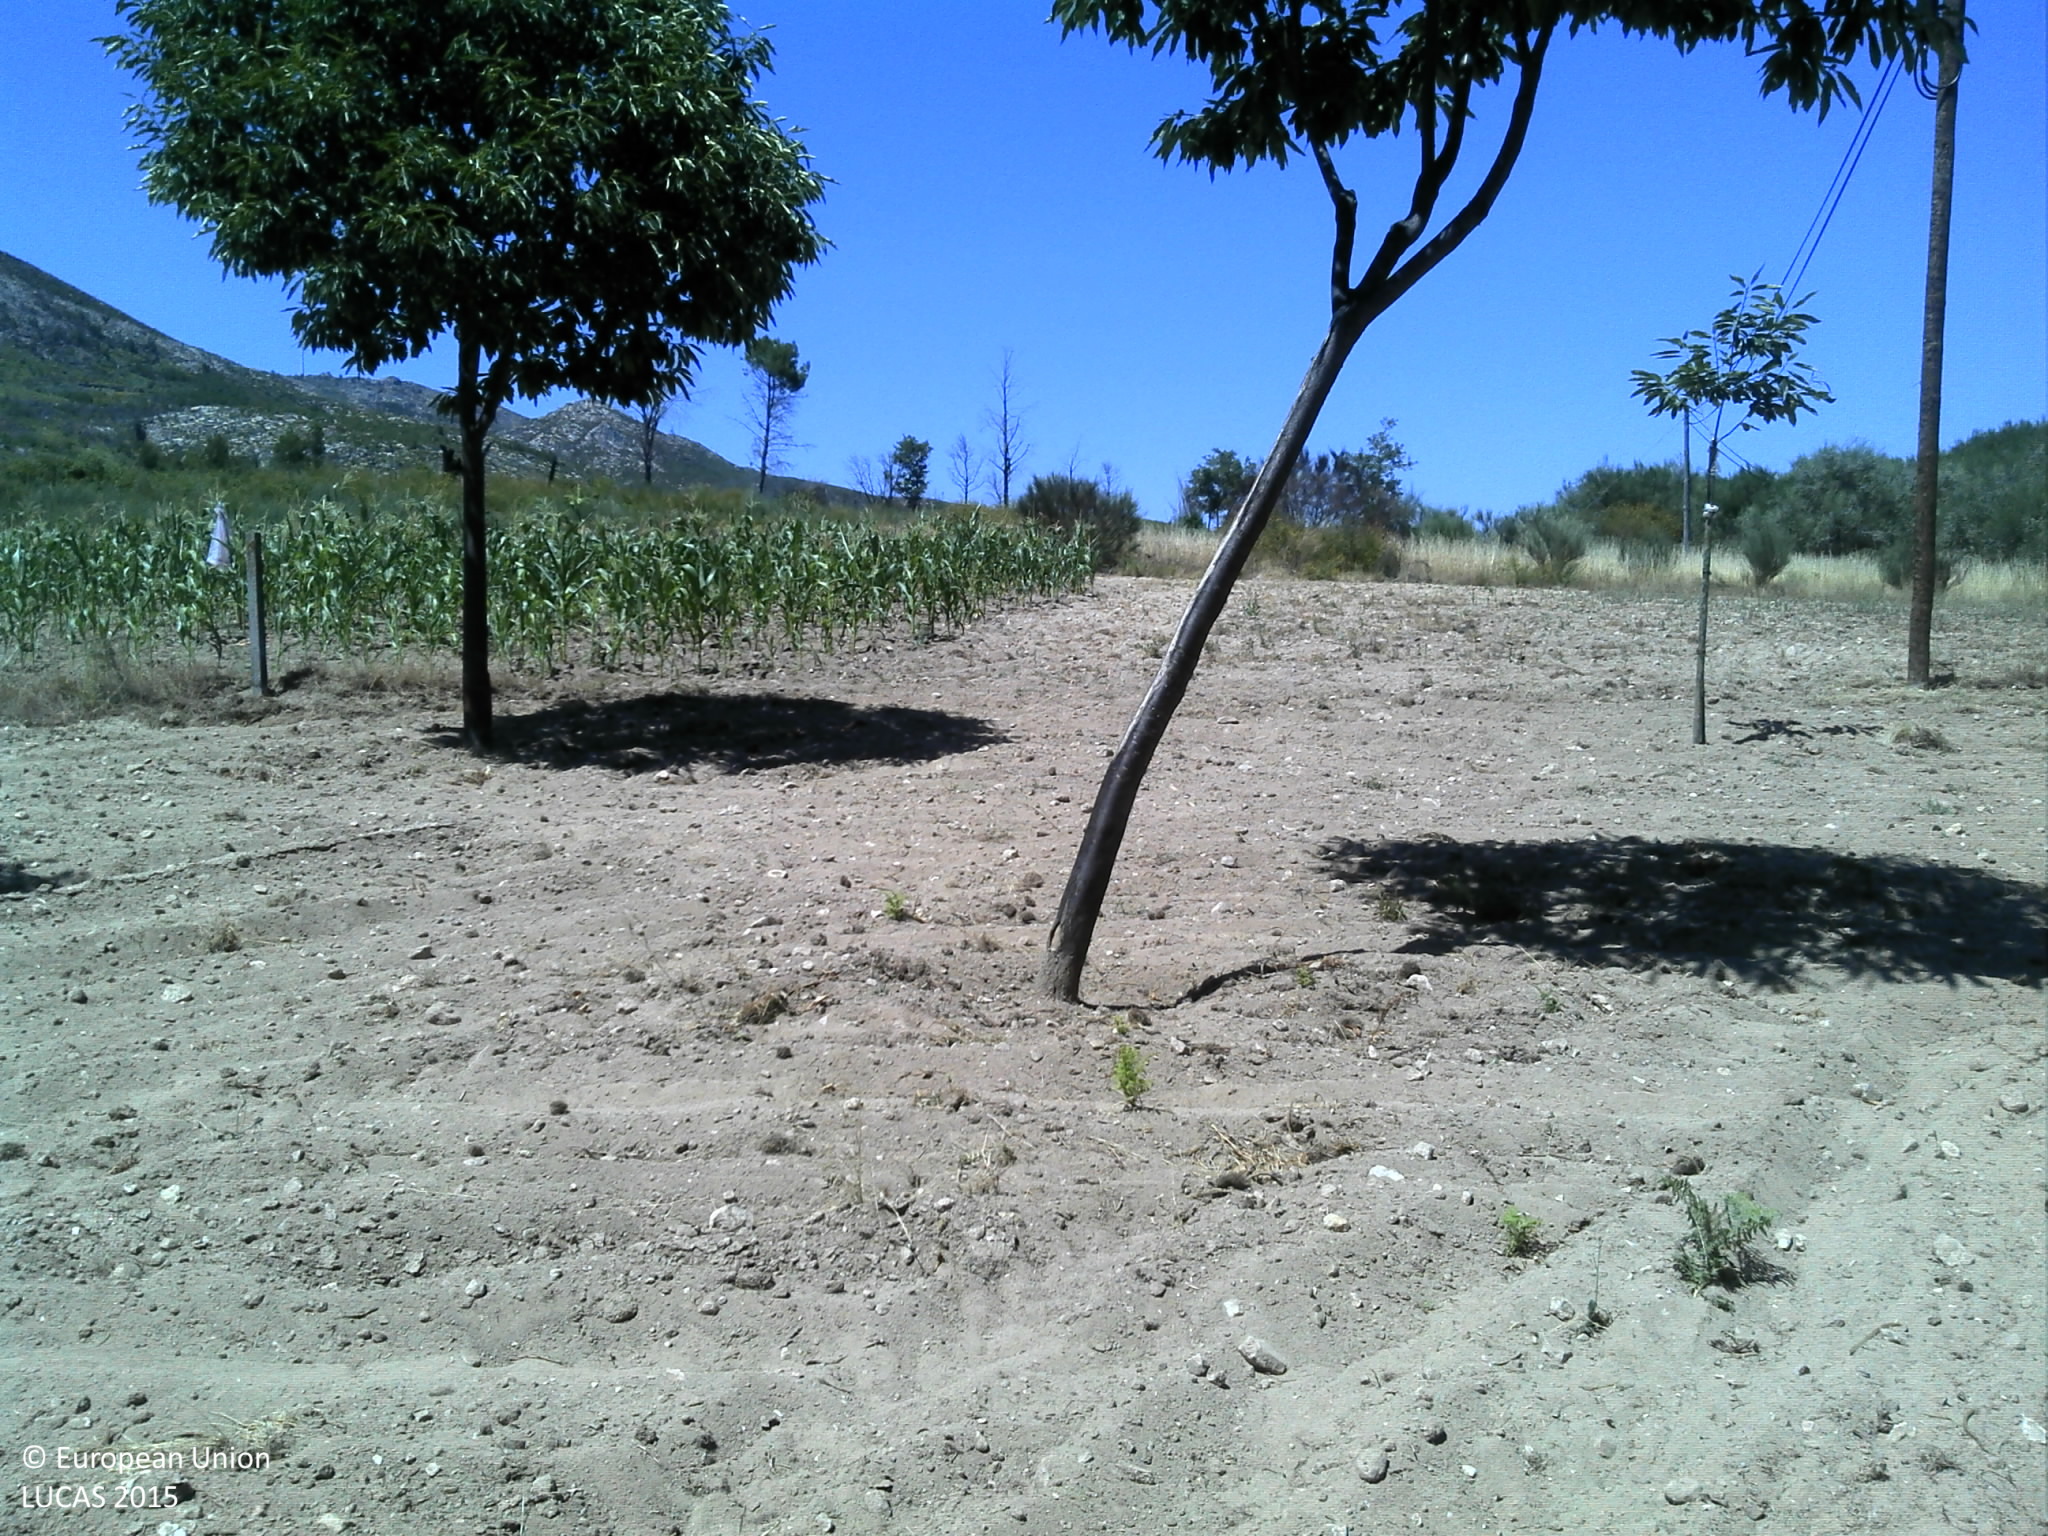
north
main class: Cropland
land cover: Nuts trees
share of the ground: 25 - 50 %
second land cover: Other bare soil
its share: > 75 %
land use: Agriculture (excluding fallow land and kitchen gardens)
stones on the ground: 10 - 25 %
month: July
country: PT
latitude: 41.7213
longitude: -7.6237
